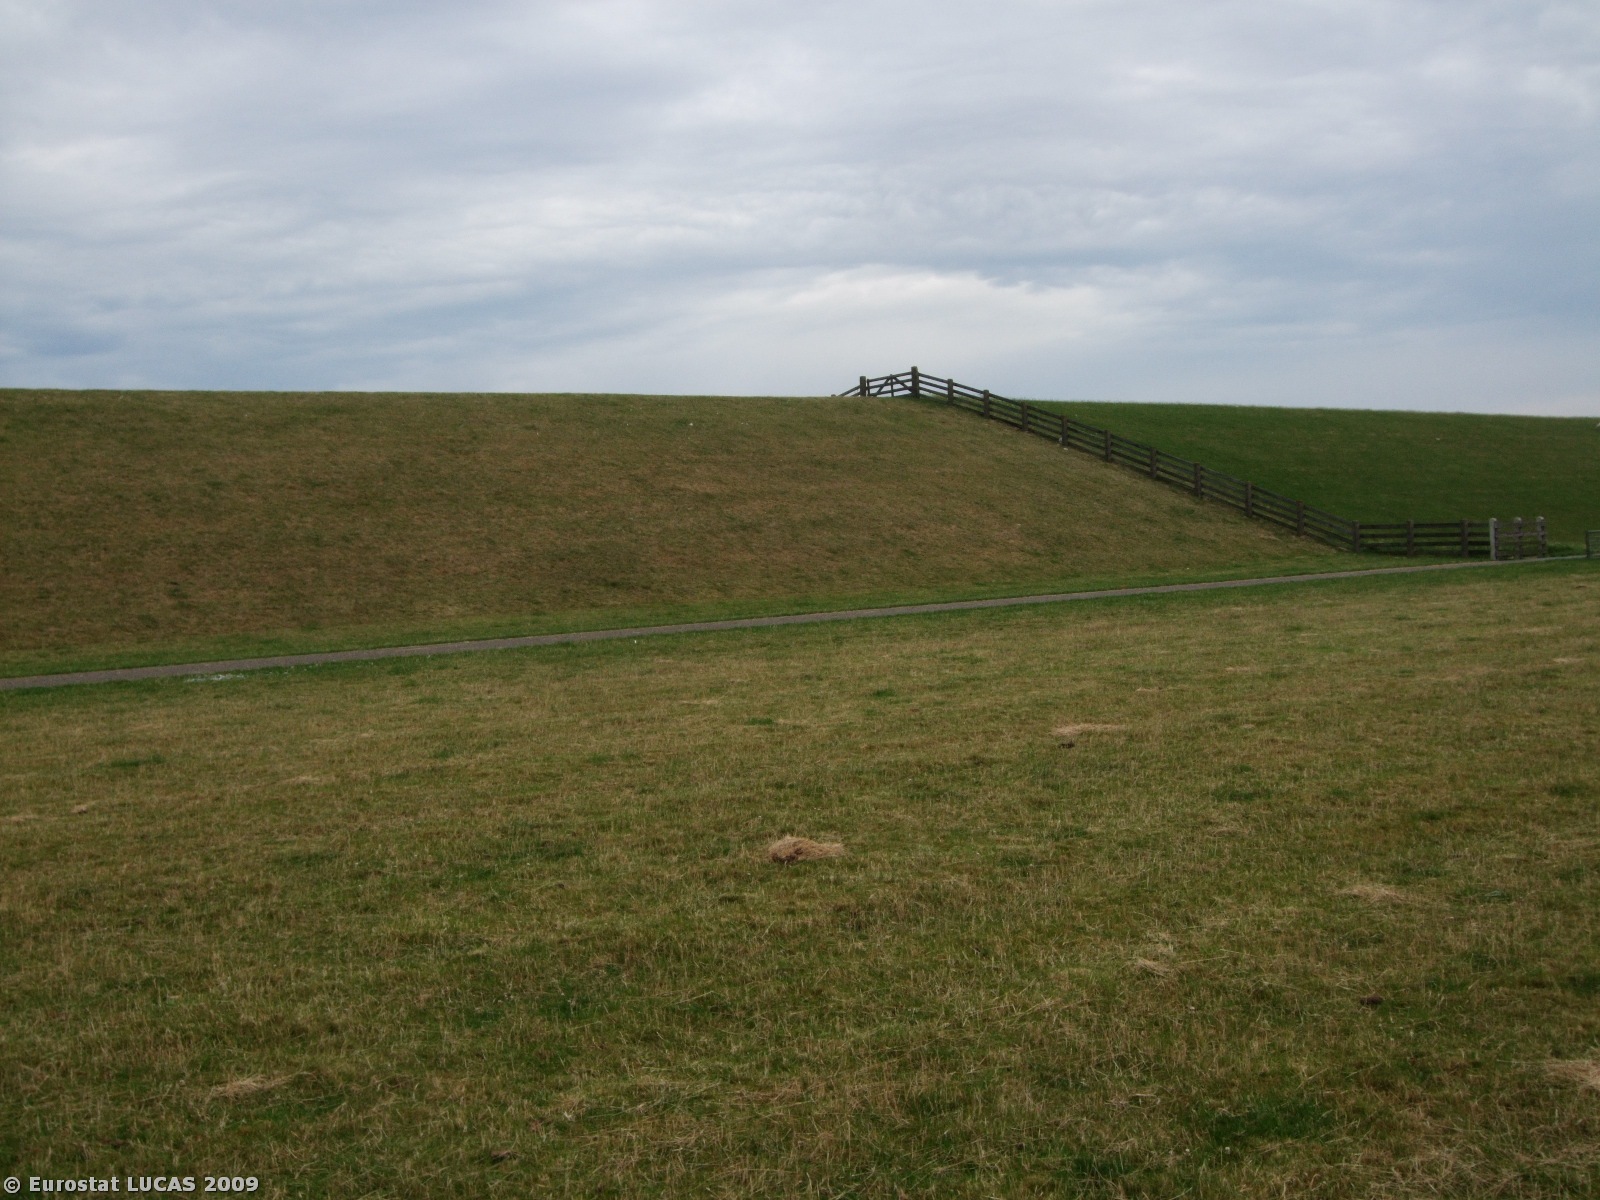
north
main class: Grassland
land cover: Grassland without tree/shrub cover
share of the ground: > 75 %
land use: Protection infrastructures
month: July
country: NL
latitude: 53.3041
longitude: 5.6021
